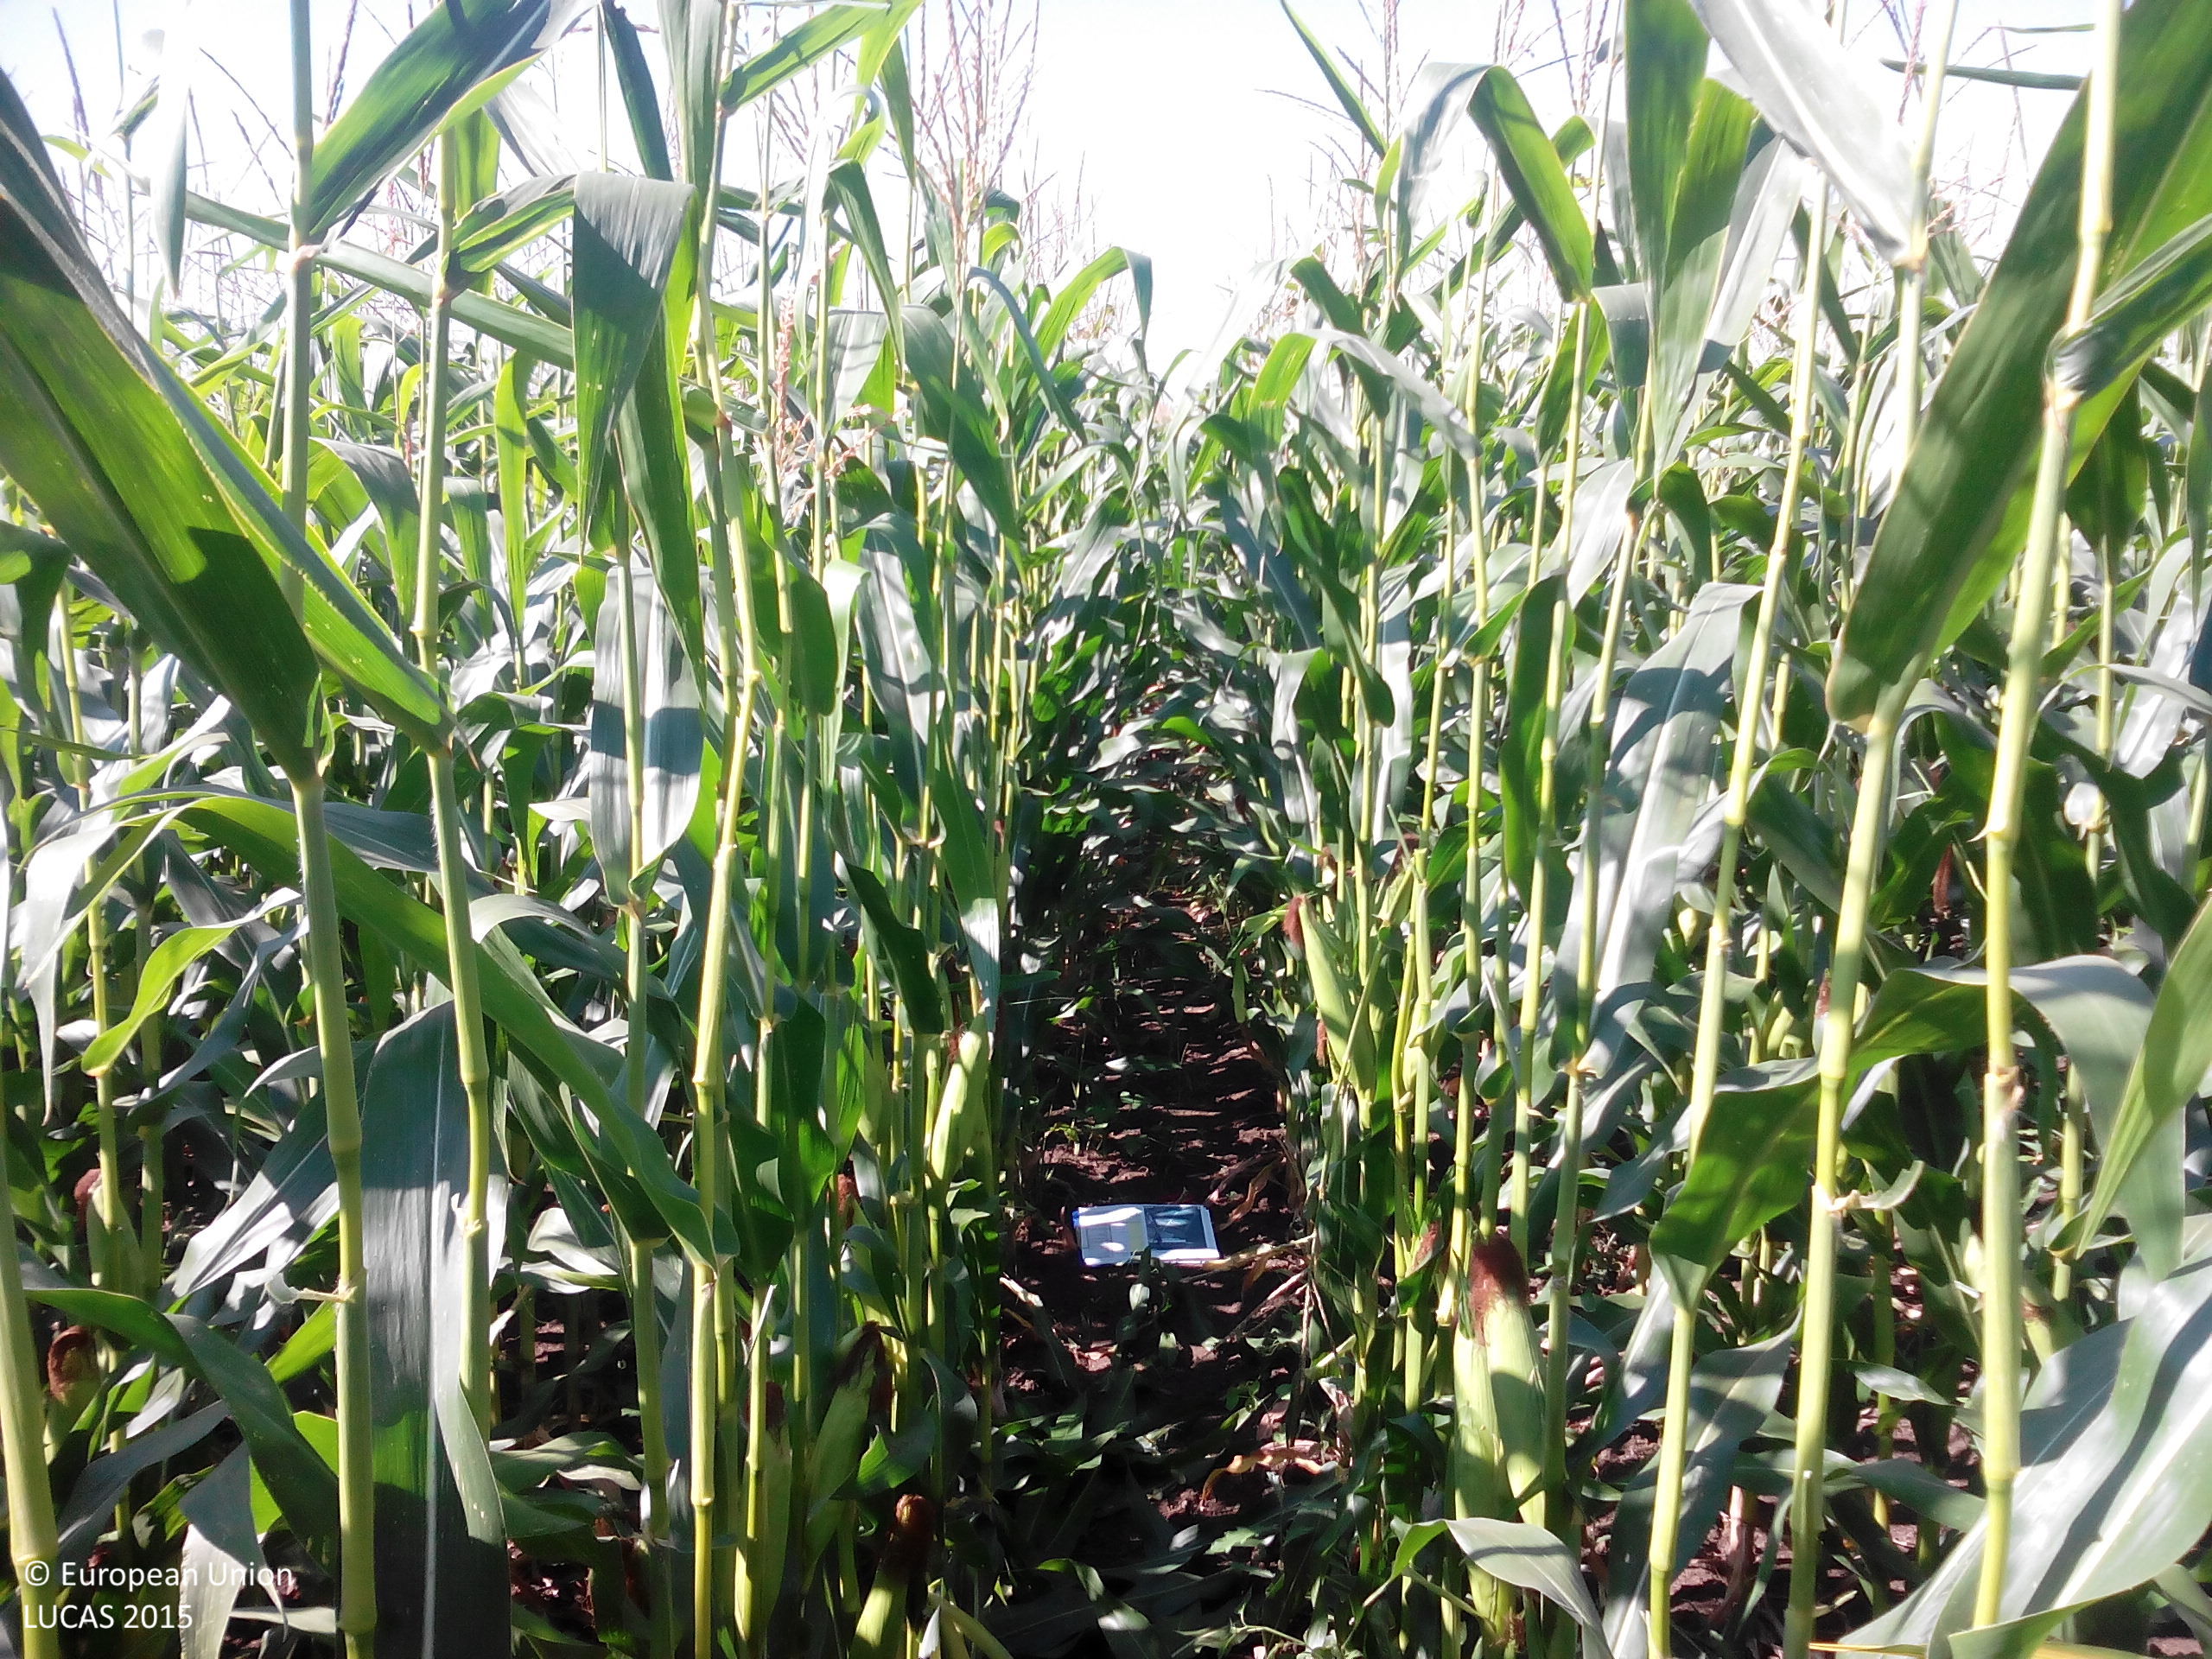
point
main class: Cropland
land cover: Maize
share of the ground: > 75 %
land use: Agriculture (excluding fallow land and kitchen gardens)
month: July
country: BG
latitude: 43.4028
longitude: 24.3441
